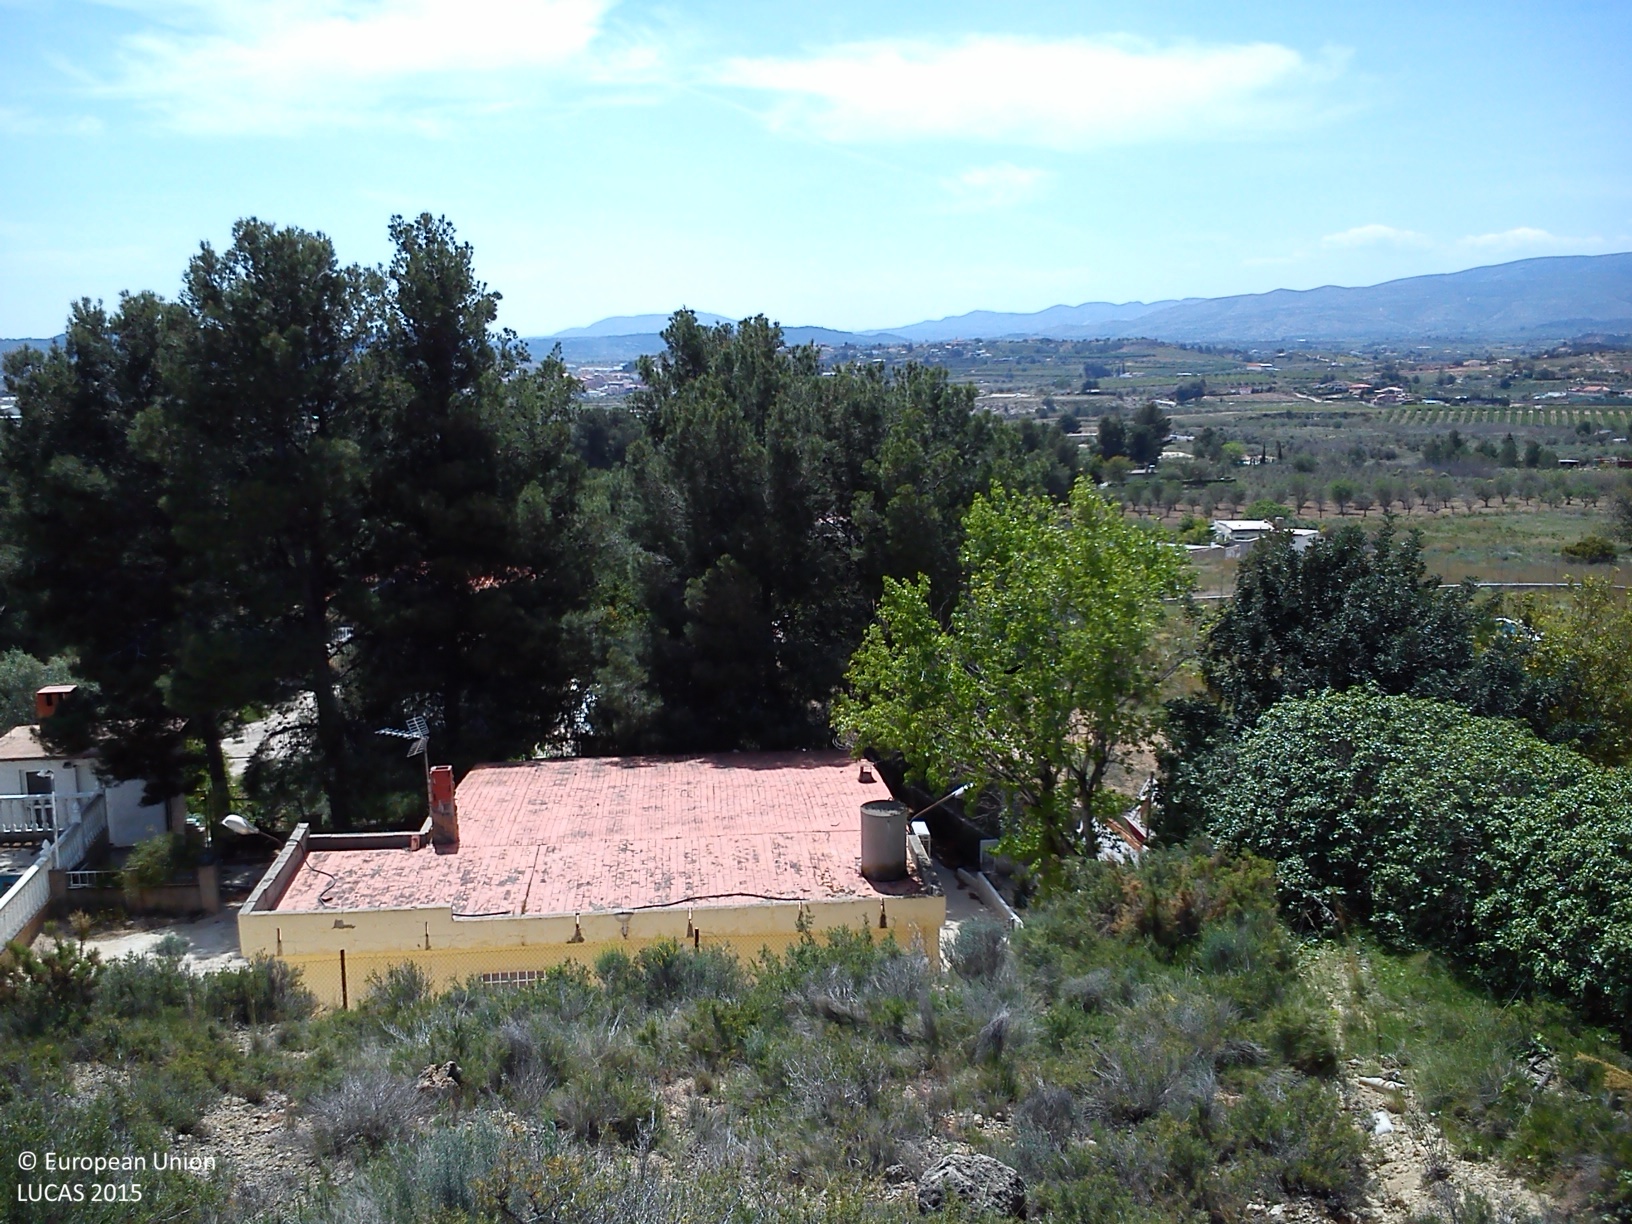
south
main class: Shrubland
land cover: Shrubland with sparse tree cover
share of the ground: > 75 %
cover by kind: shrubs 70 %, herbaceous plants 15 %, consolidated bare surface 10 %, coniferous forest trees 5 %
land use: Semi-natural and natural areas not in use
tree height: < 5 m
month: April
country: ES
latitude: 39.3613
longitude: -0.6166
